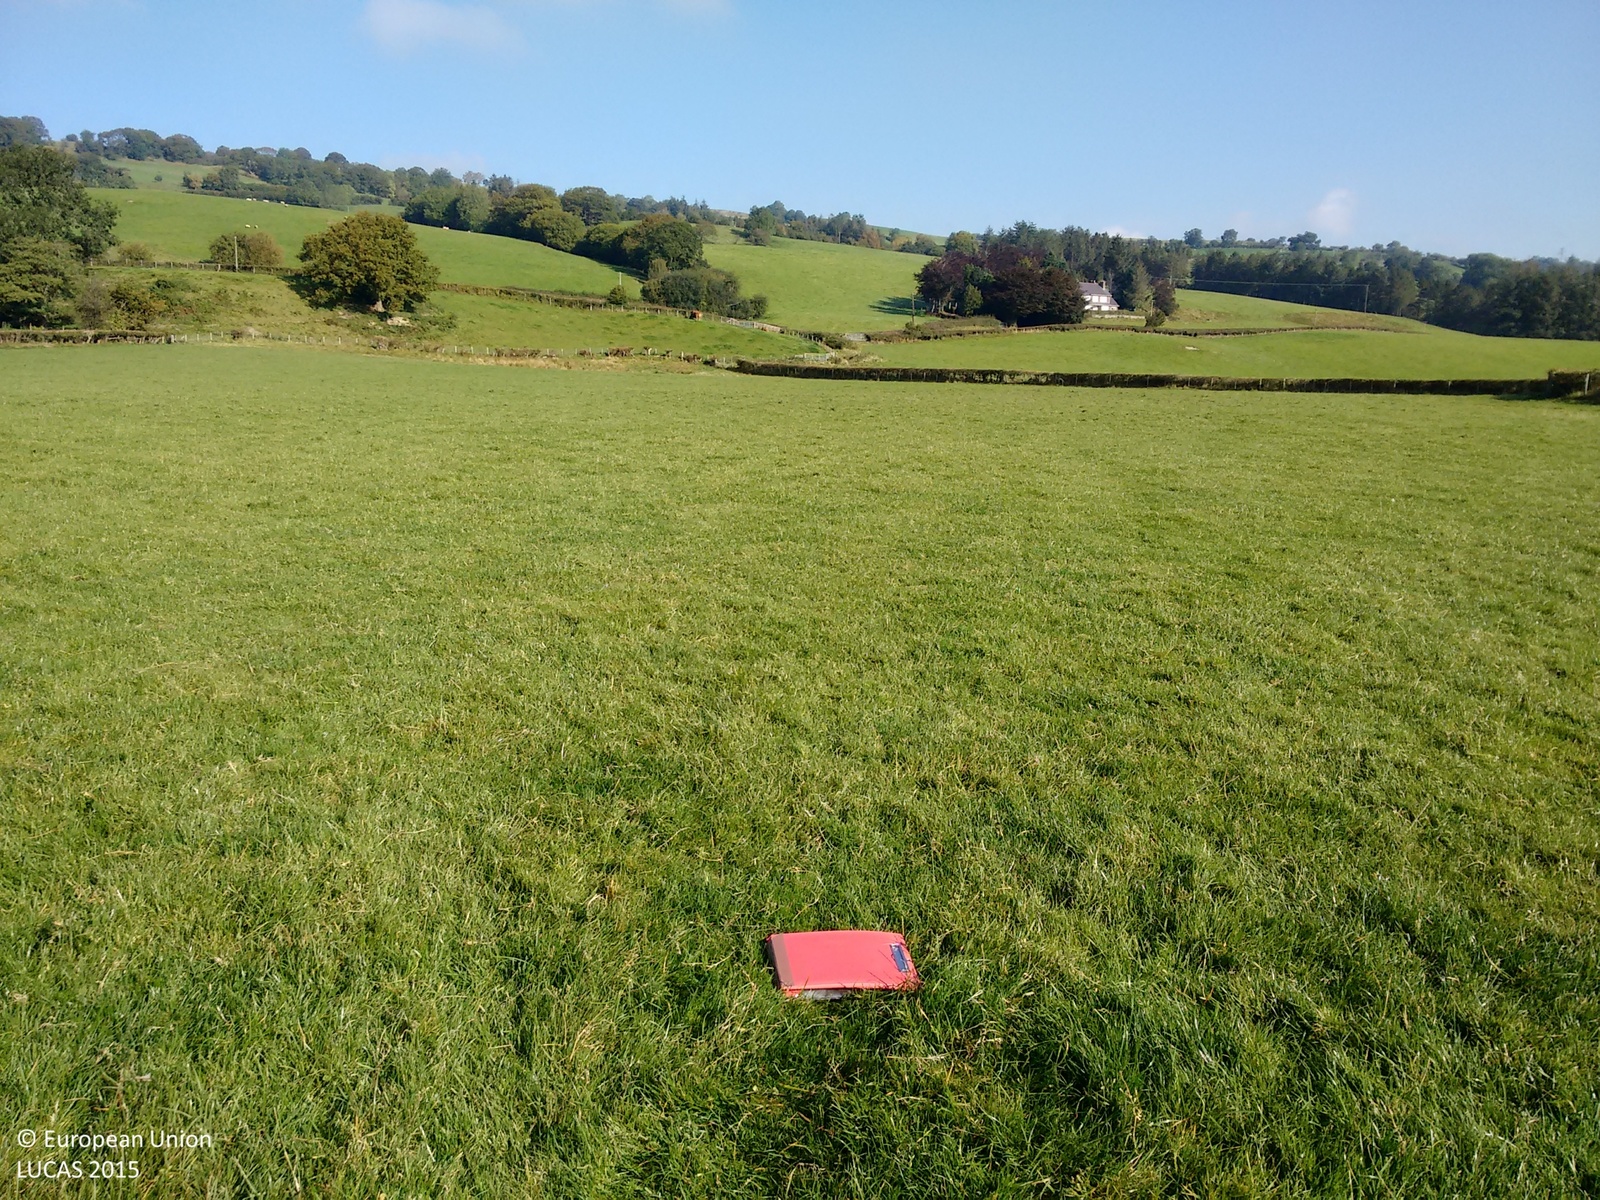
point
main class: Grassland
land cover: Grassland without tree/shrub cover
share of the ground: > 75 %
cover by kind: herbaceous plants 100 %
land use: Agriculture (excluding fallow land and kitchen gardens)
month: October
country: GB
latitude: 52.6878
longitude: -3.4120
